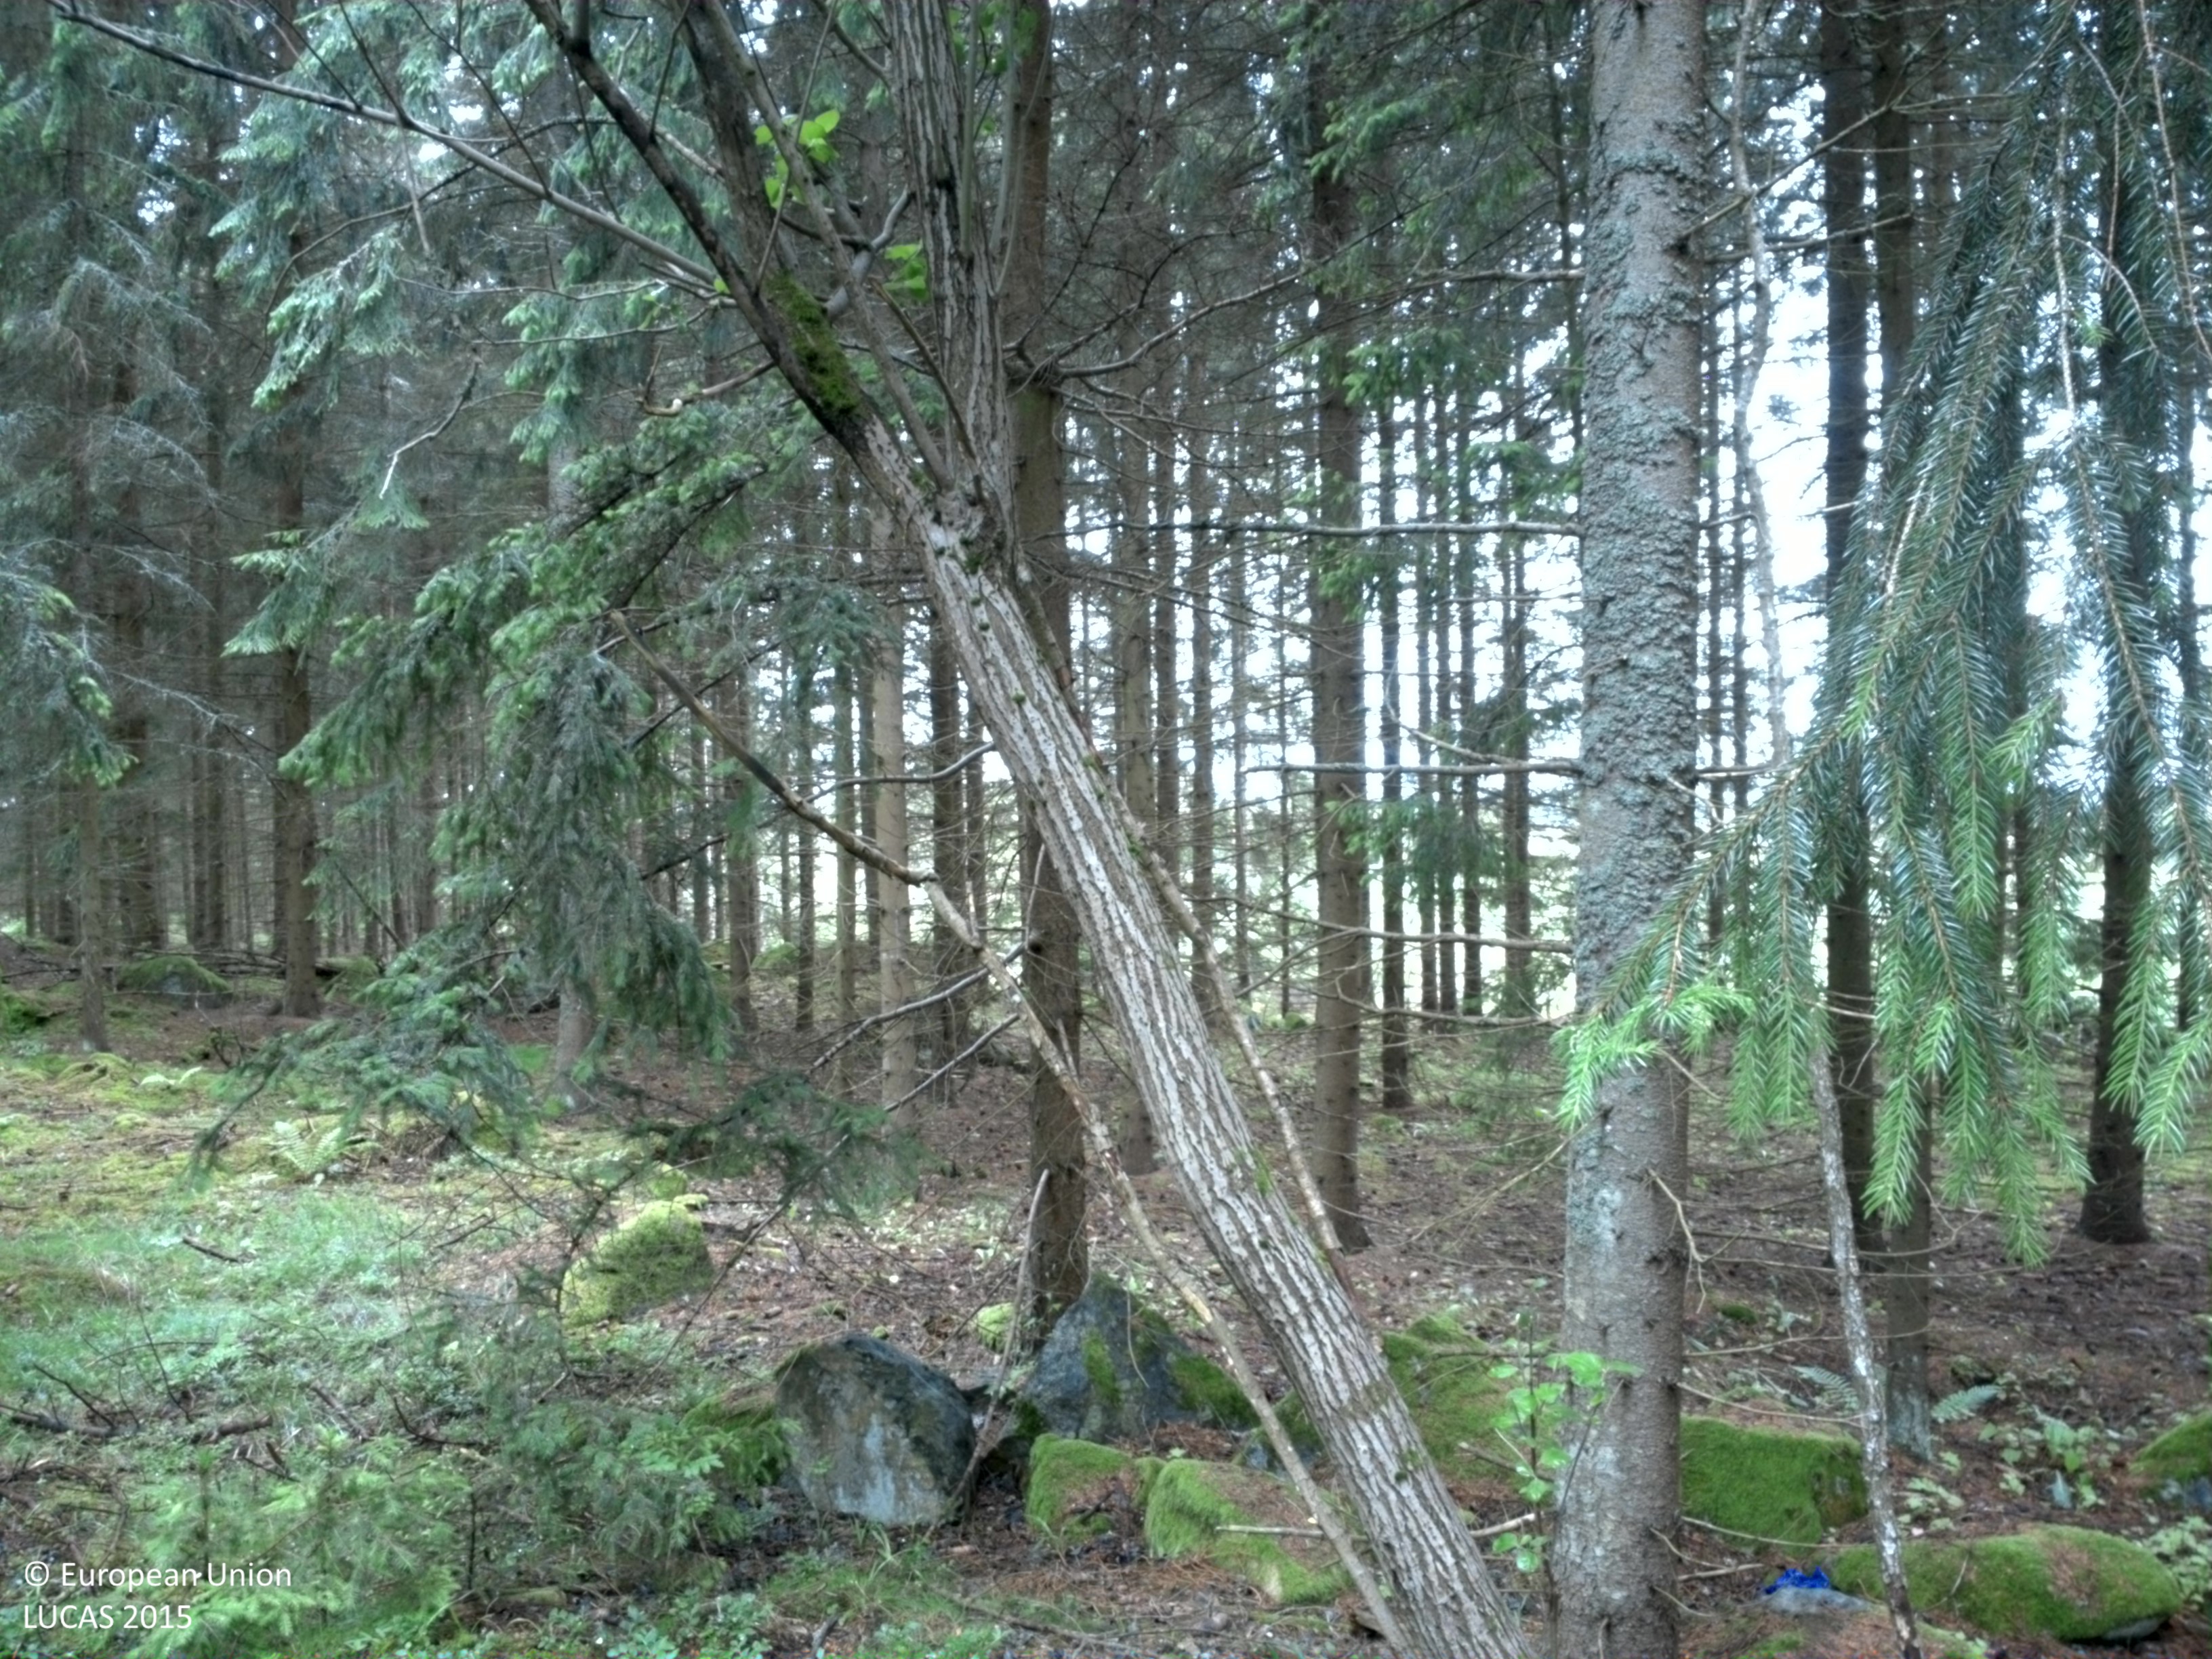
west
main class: Woodland
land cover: Spruce dominated coniferous woodland
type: boreal forest
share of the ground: > 75 %
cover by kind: coniferous forest trees 70 %, herbaceous plants 20 %, broadleaved forest trees 5 %, lichens and mosses 5 %
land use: Forestry
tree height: > 5 m
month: June
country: SE
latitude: 59.6273
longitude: 16.9970
